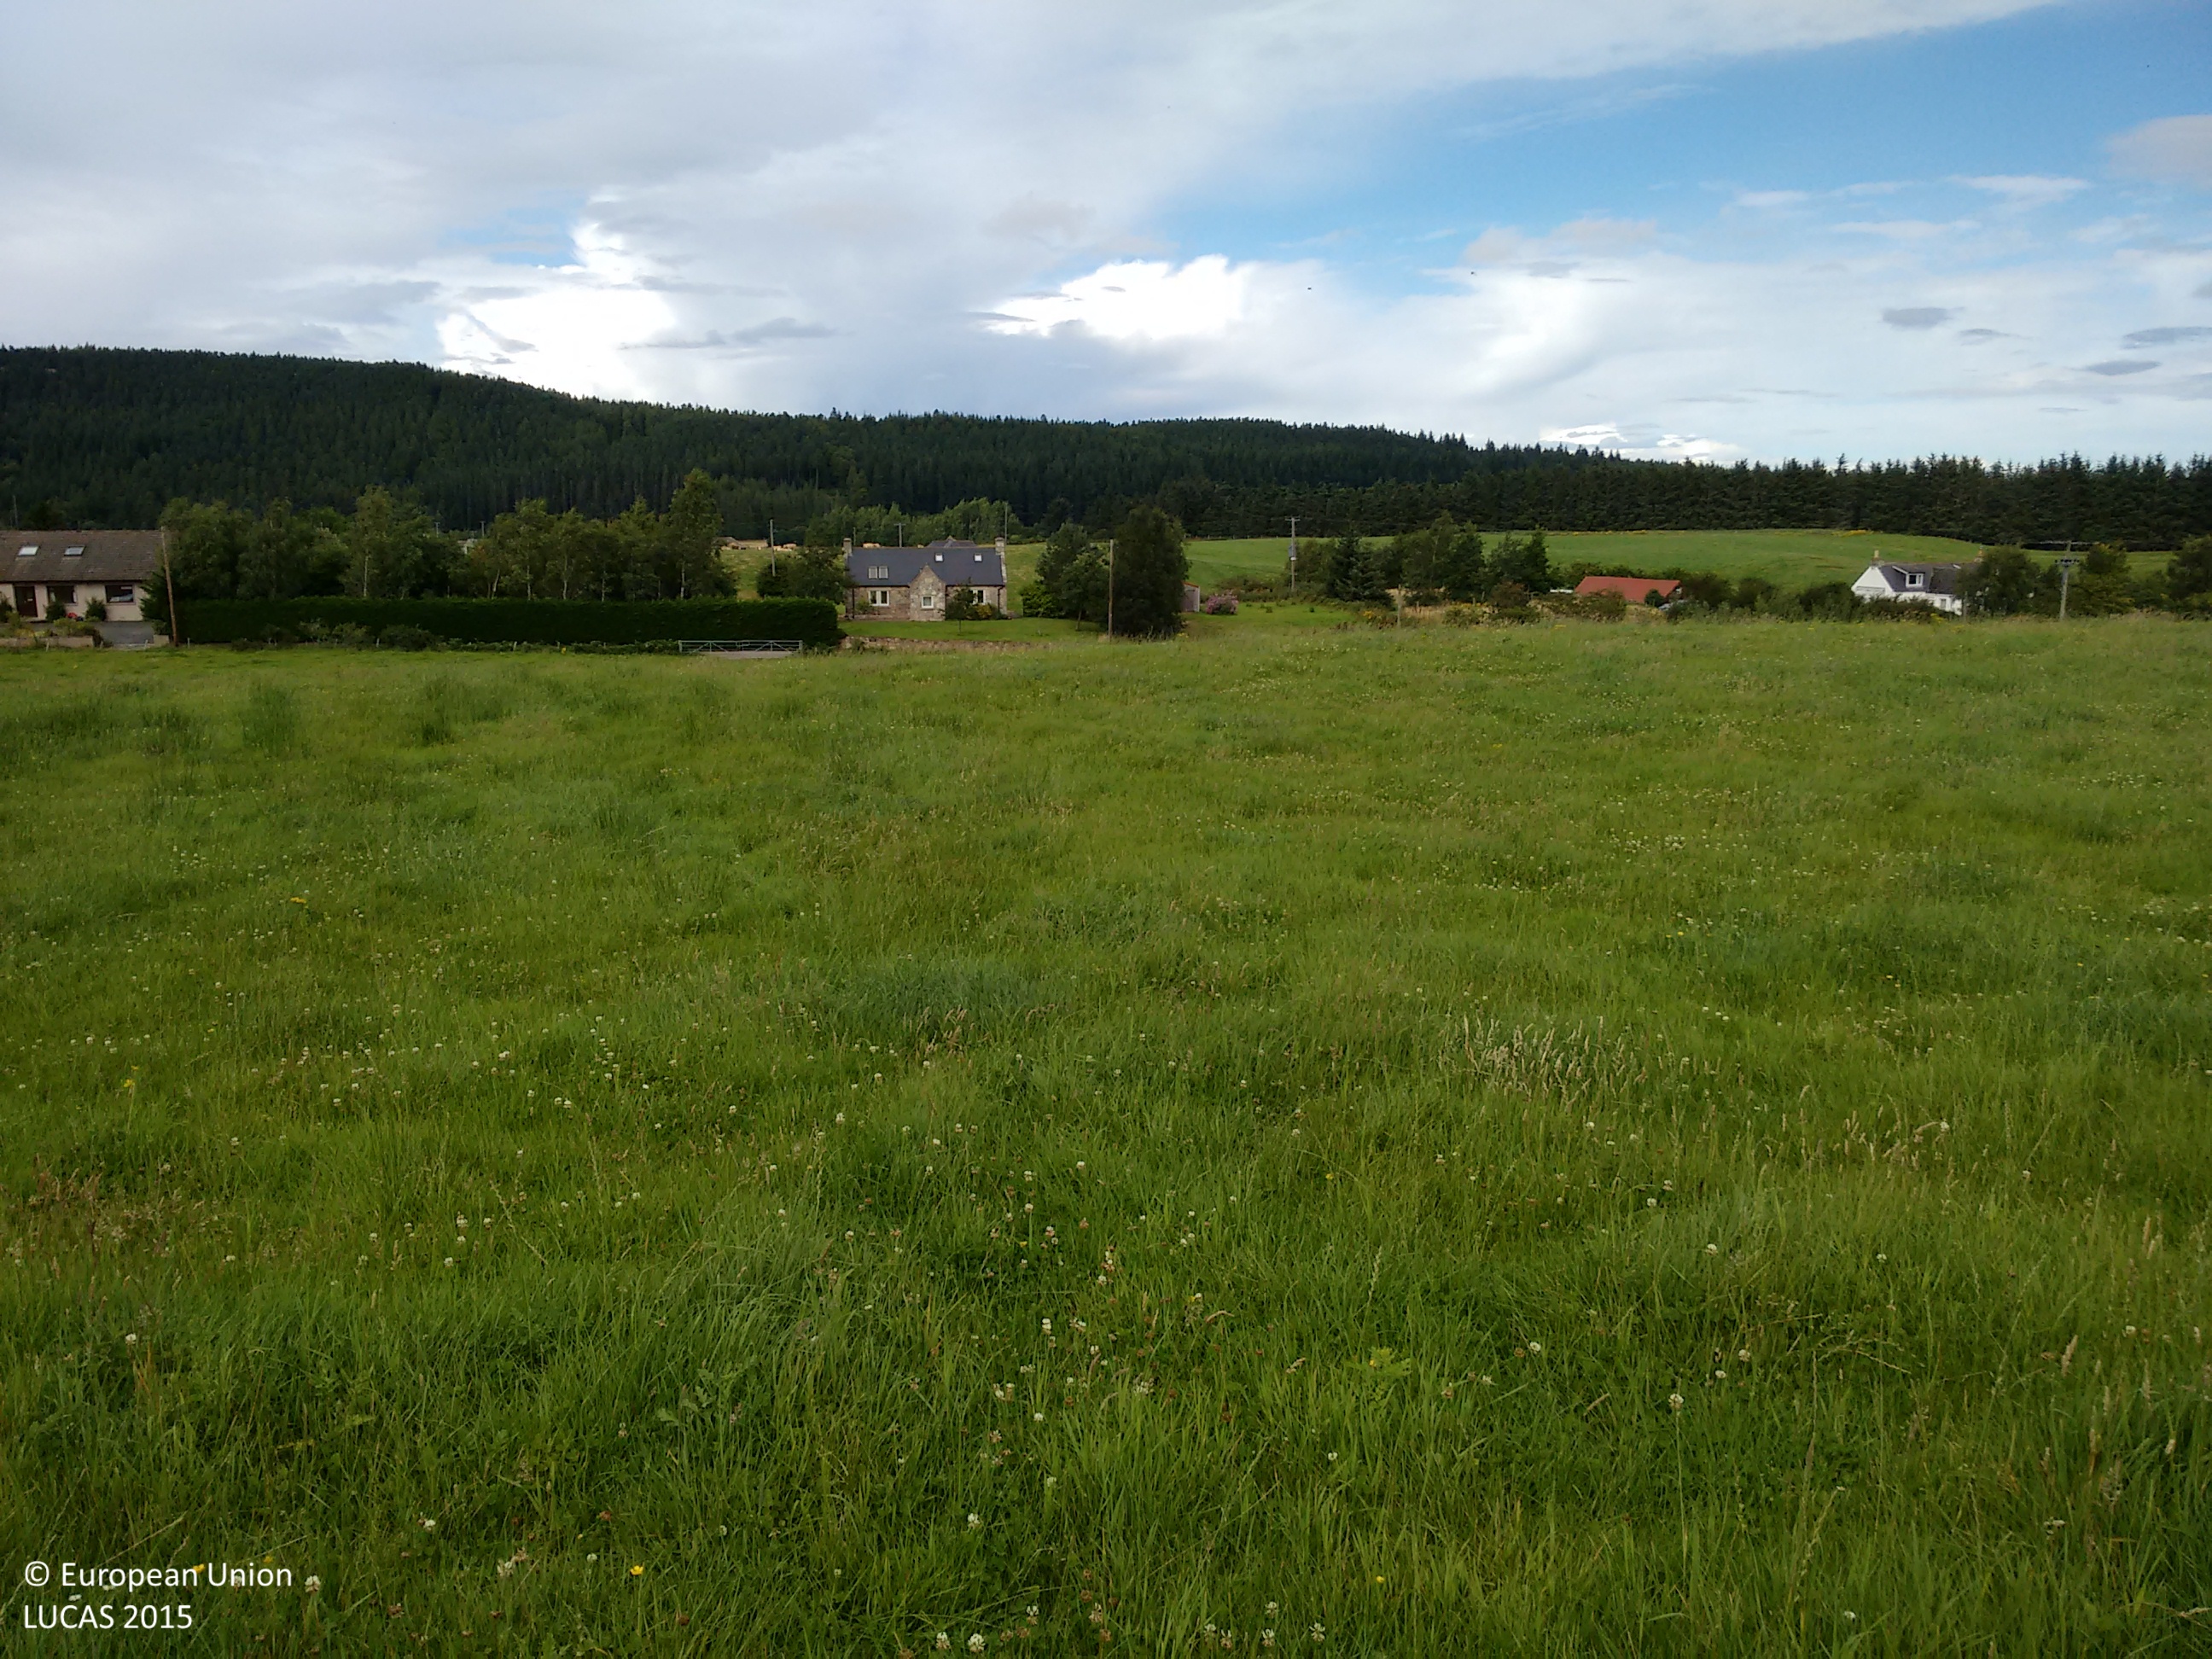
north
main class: Grassland
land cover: Grassland without tree/shrub cover
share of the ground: > 75 %
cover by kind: herbaceous plants 100 %
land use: Agriculture (excluding fallow land and kitchen gardens)
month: August
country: GB
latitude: 57.5988
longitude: -3.4038
